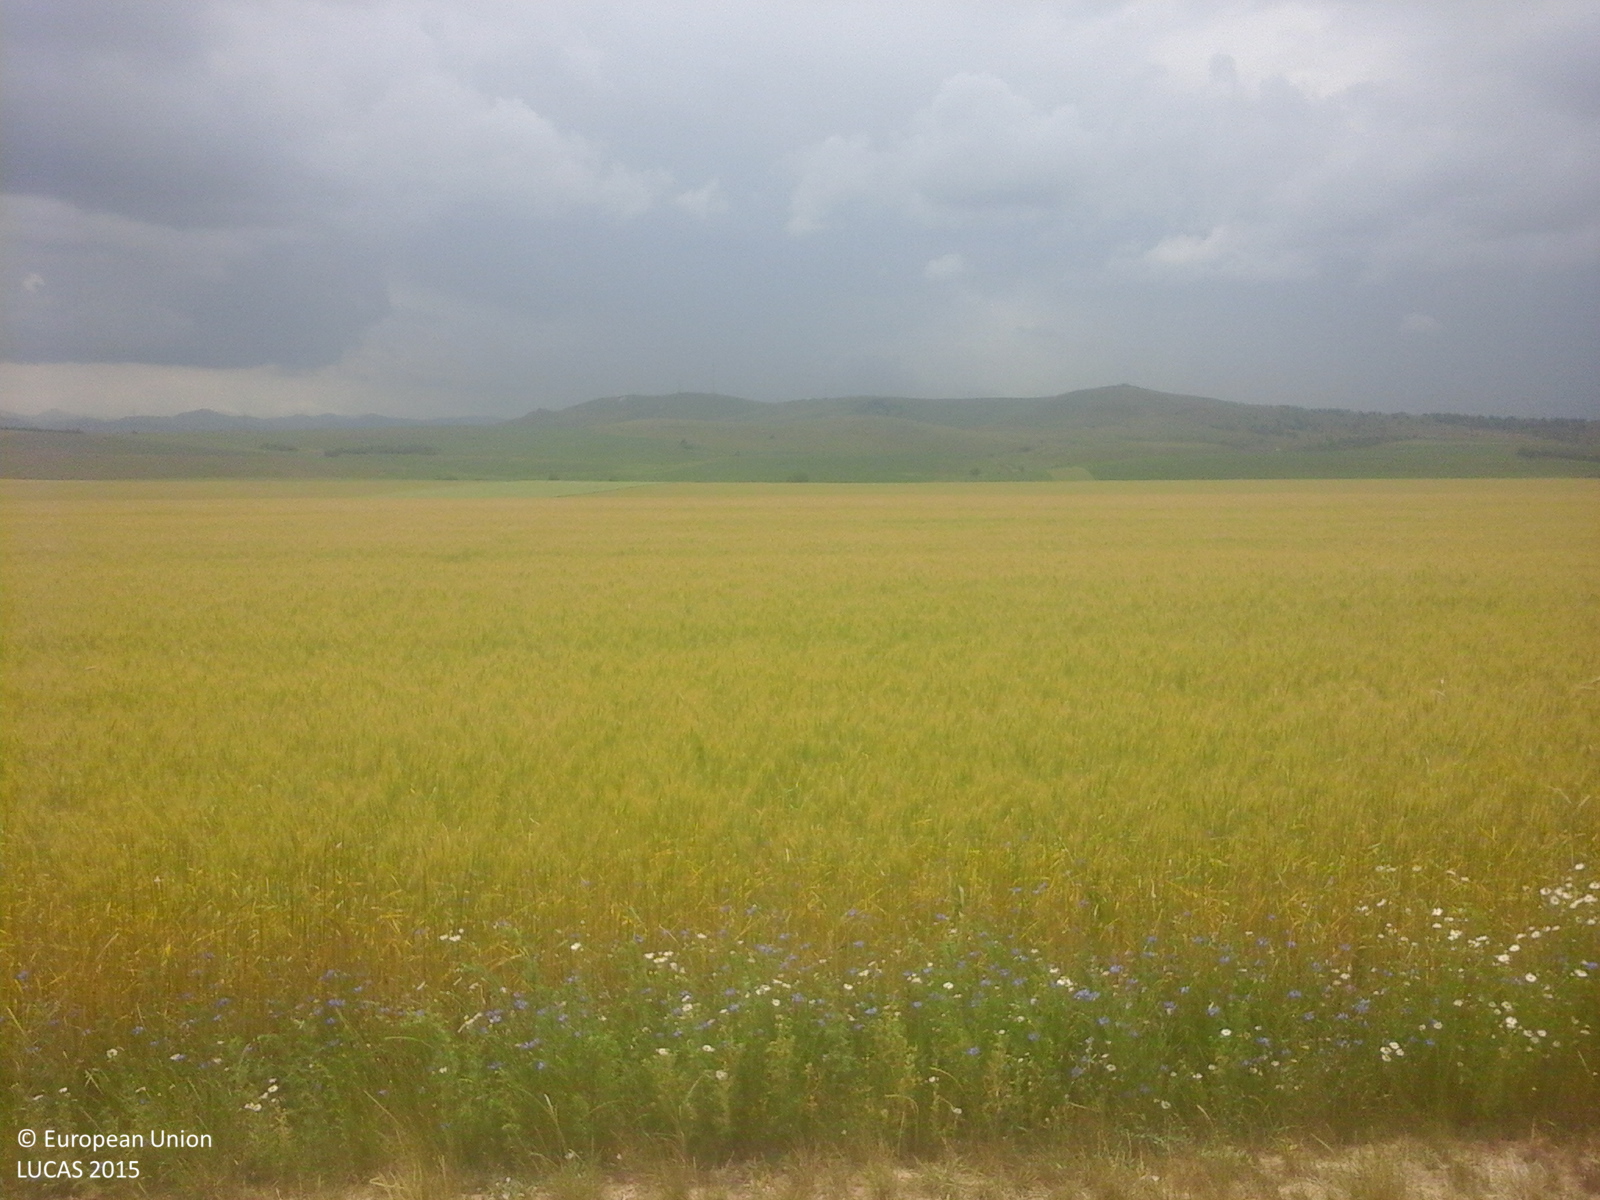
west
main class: Cropland
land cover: Common wheat
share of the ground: > 75 %
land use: Agriculture (excluding fallow land and kitchen gardens)
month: June
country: RO
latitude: 46.9955
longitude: 26.5643
